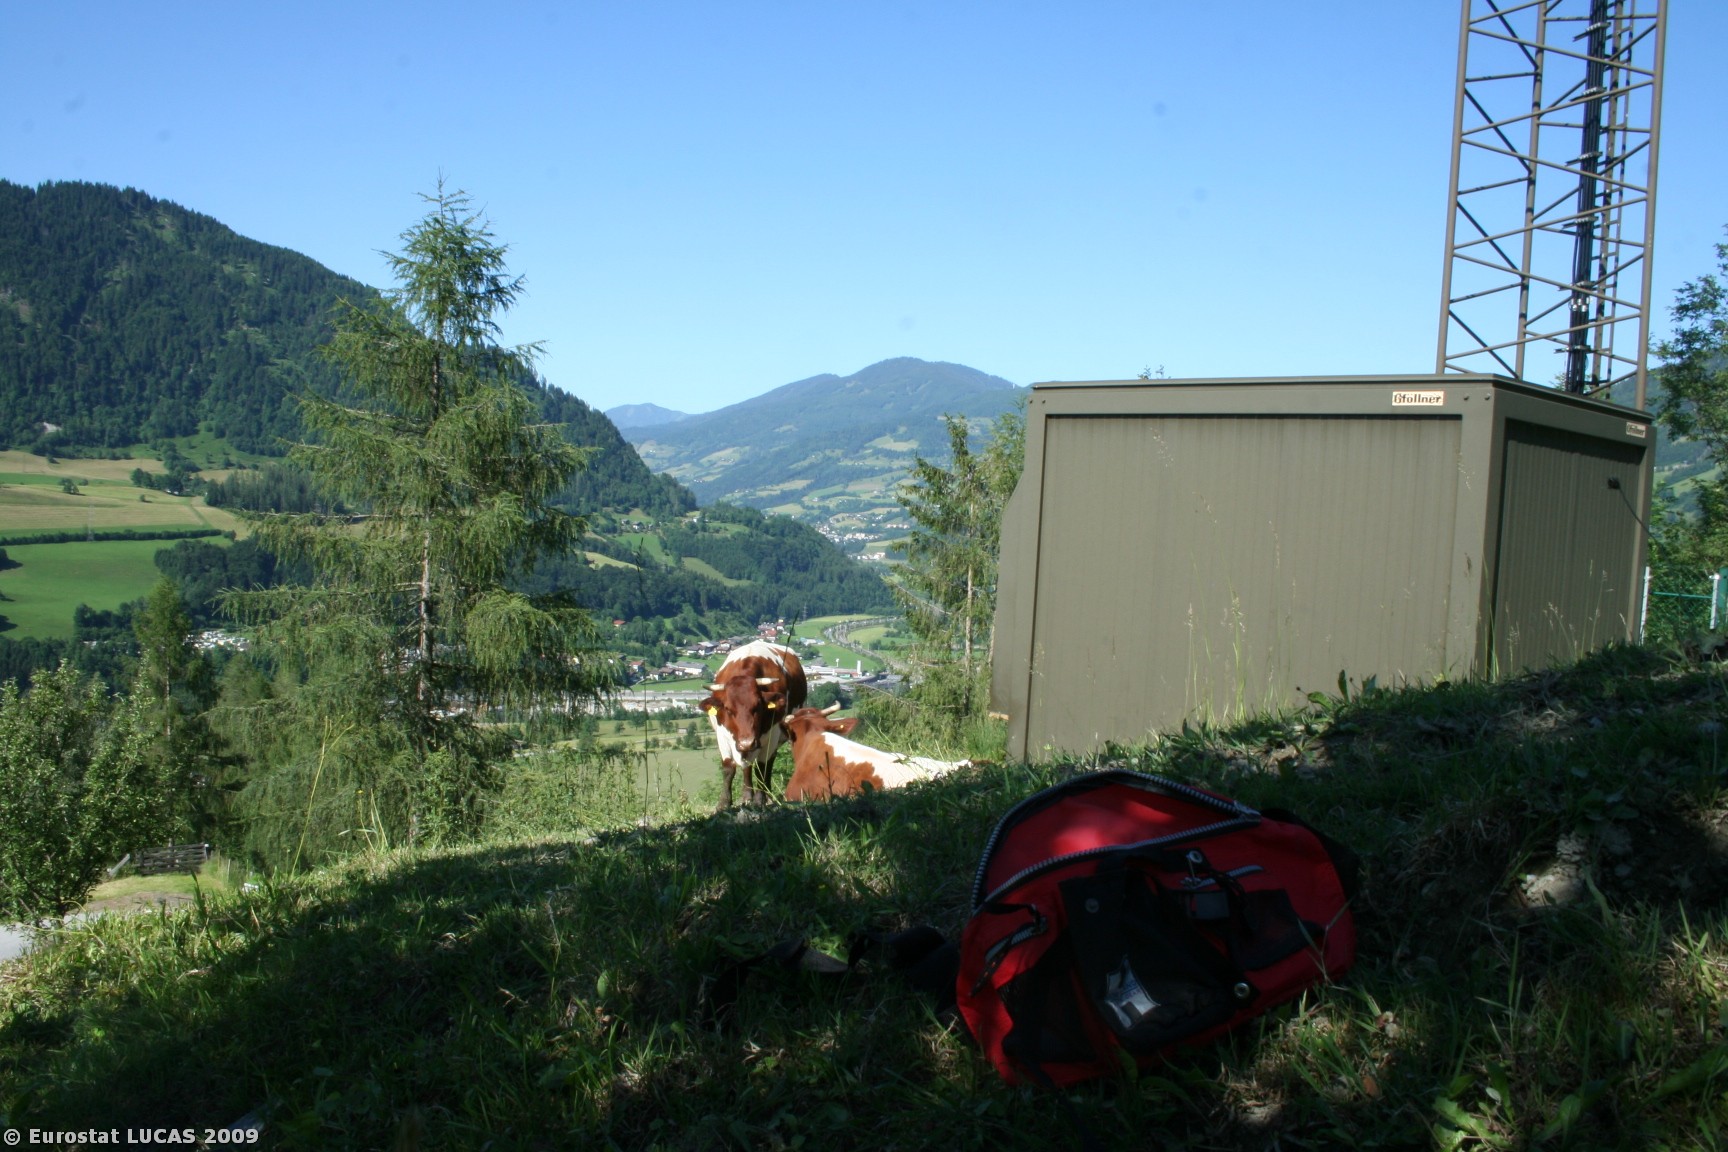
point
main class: Grassland
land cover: Grassland with sparse tree/shrub cover
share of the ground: > 75 %
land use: Agriculture (excluding fallow land and kitchen gardens)
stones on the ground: < 10 %
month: June
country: AT
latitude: 47.3137
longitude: 13.1597
